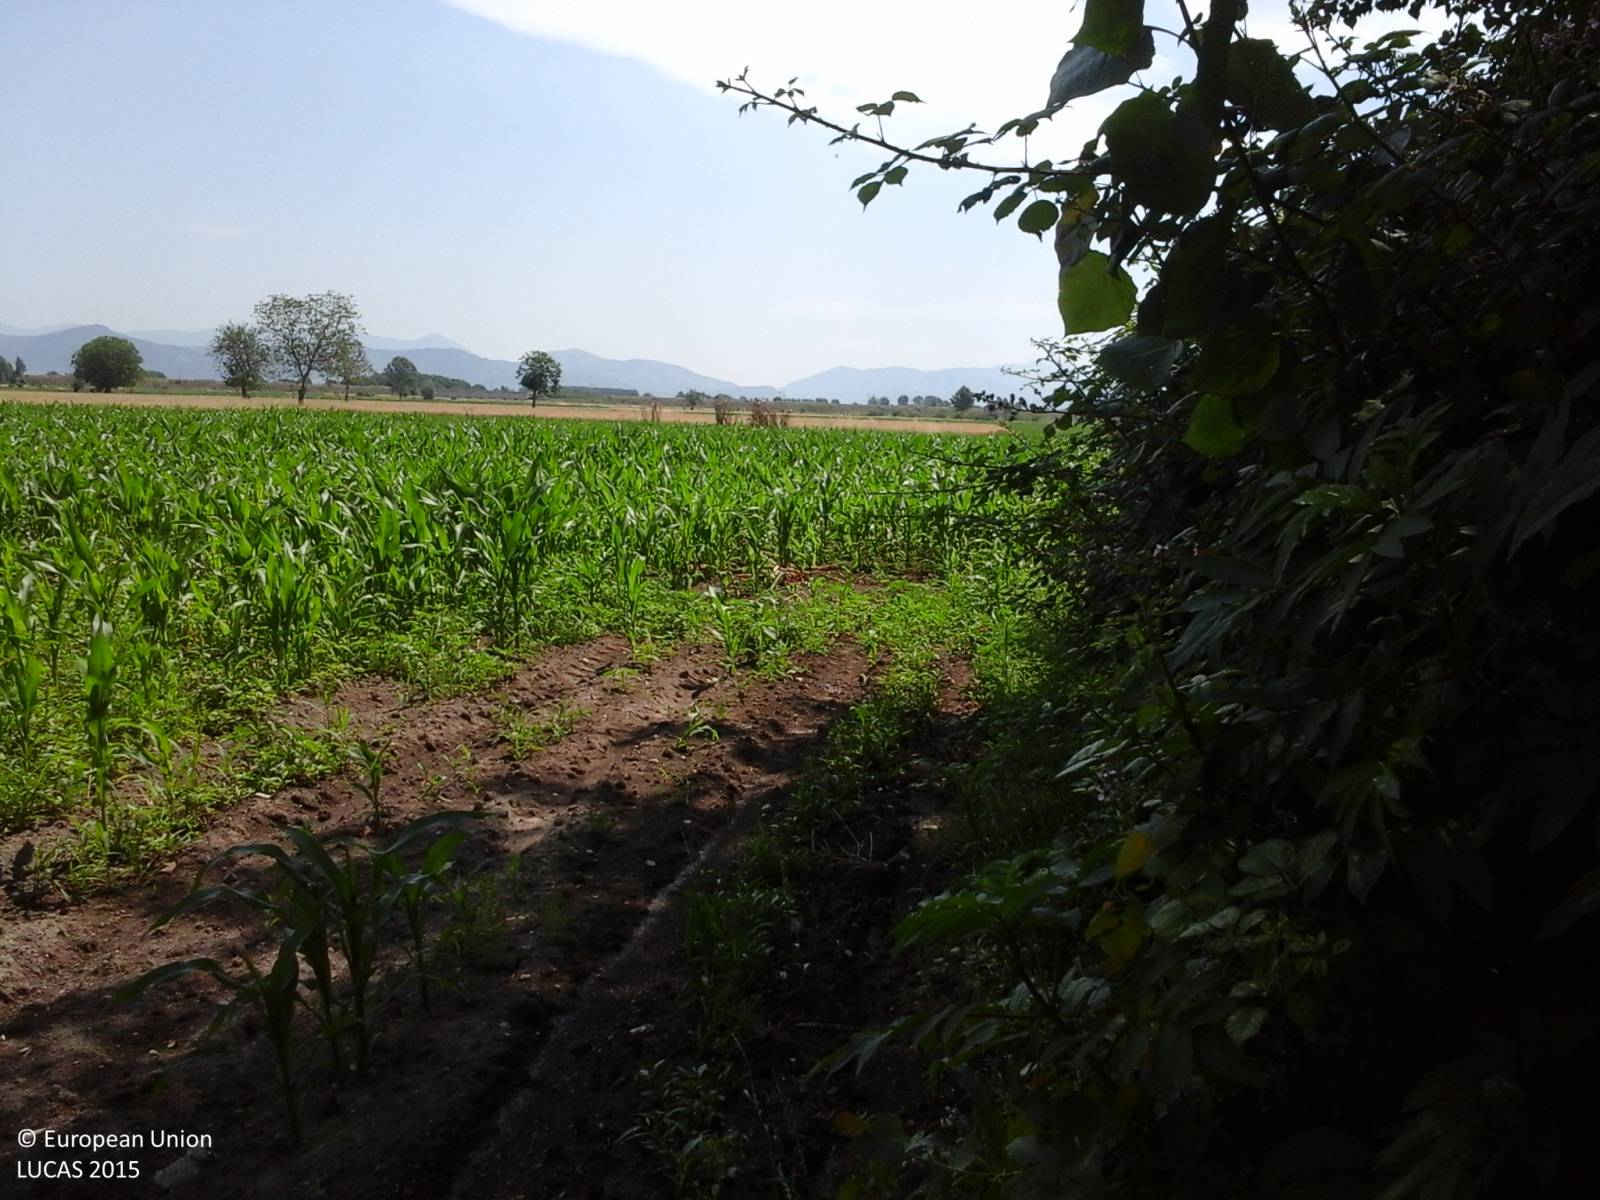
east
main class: Woodland
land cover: Broadleaved woodland
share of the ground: > 75 %
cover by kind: broadleaved forest trees 100 %
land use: Semi-natural and natural areas not in use
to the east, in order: Broadleaved woodland; Grass margins; Maize; Spontaneously vegetated surfaces; Tomatoes; Grass margins; Barley; Tomatoes
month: June
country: IT
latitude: 41.0266
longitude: 14.2525
